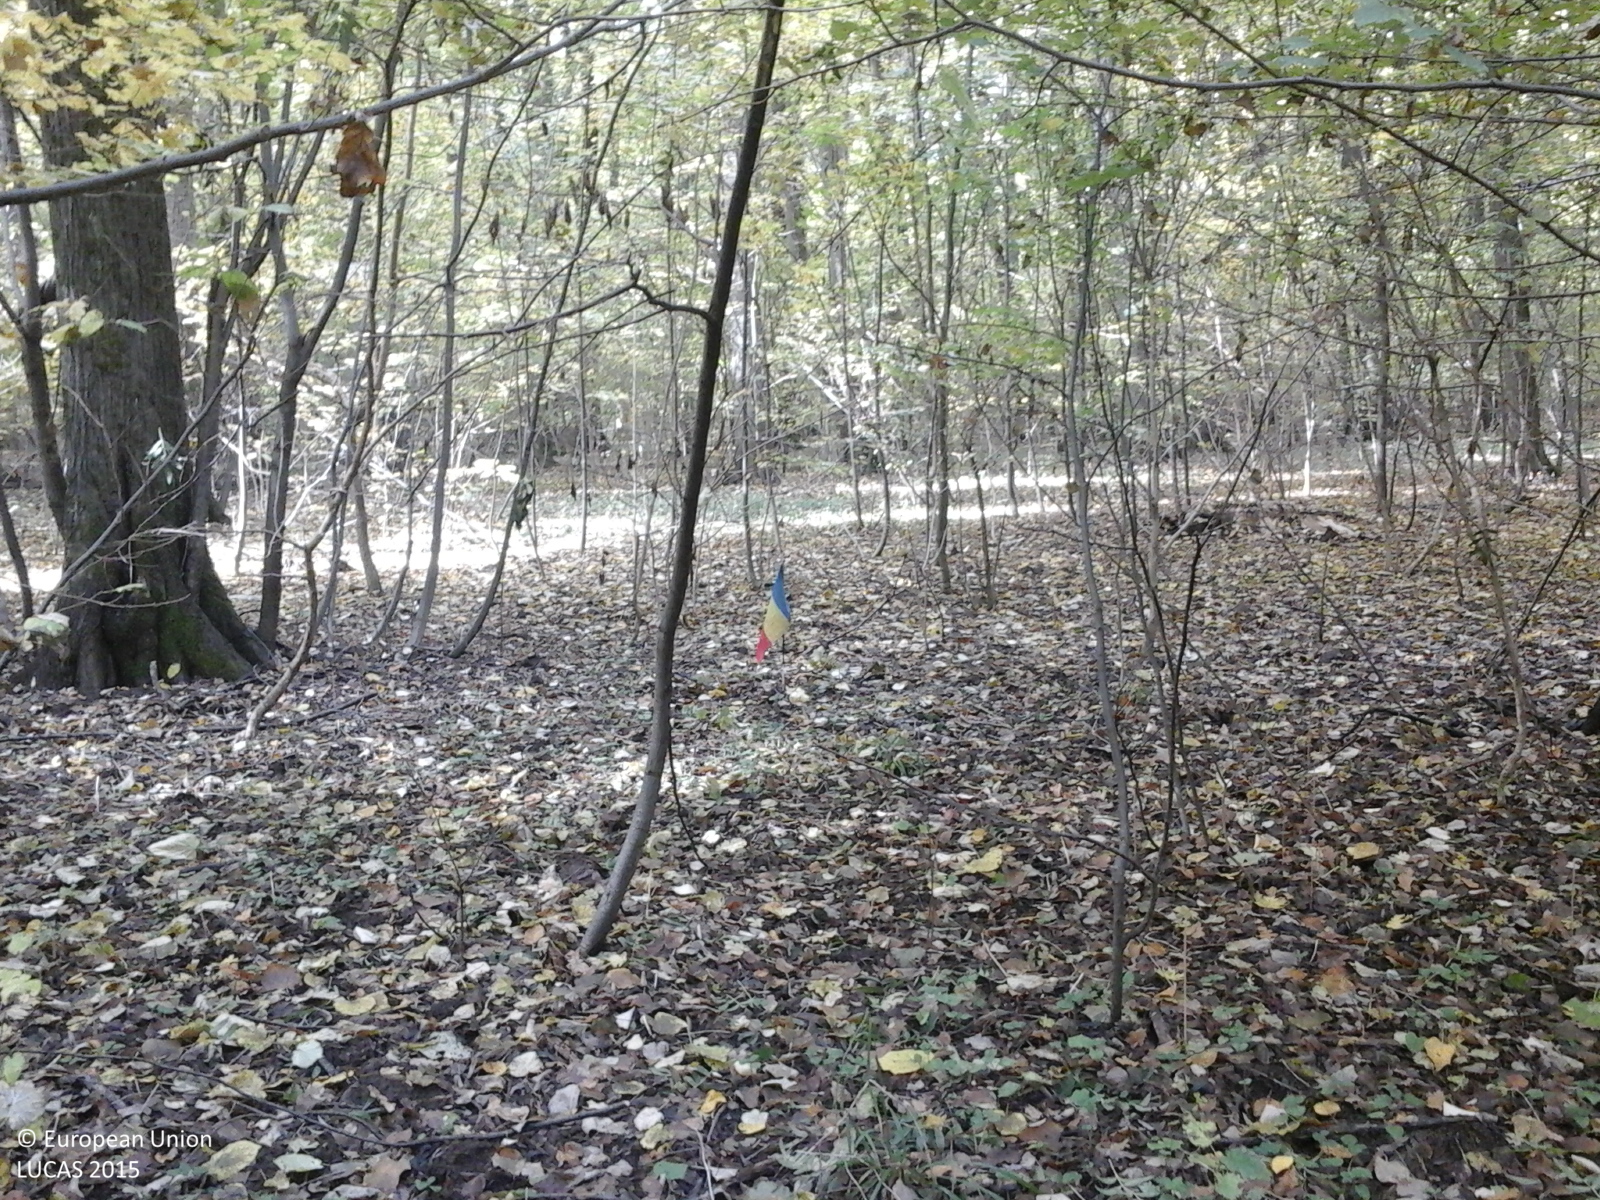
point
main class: Woodland
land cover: Broadleaved woodland
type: beech forest
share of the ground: > 75 %
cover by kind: broadleaved forest trees 100 %
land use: Forestry
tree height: > 5 m
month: October
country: RO
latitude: 44.7094
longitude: 26.1520
